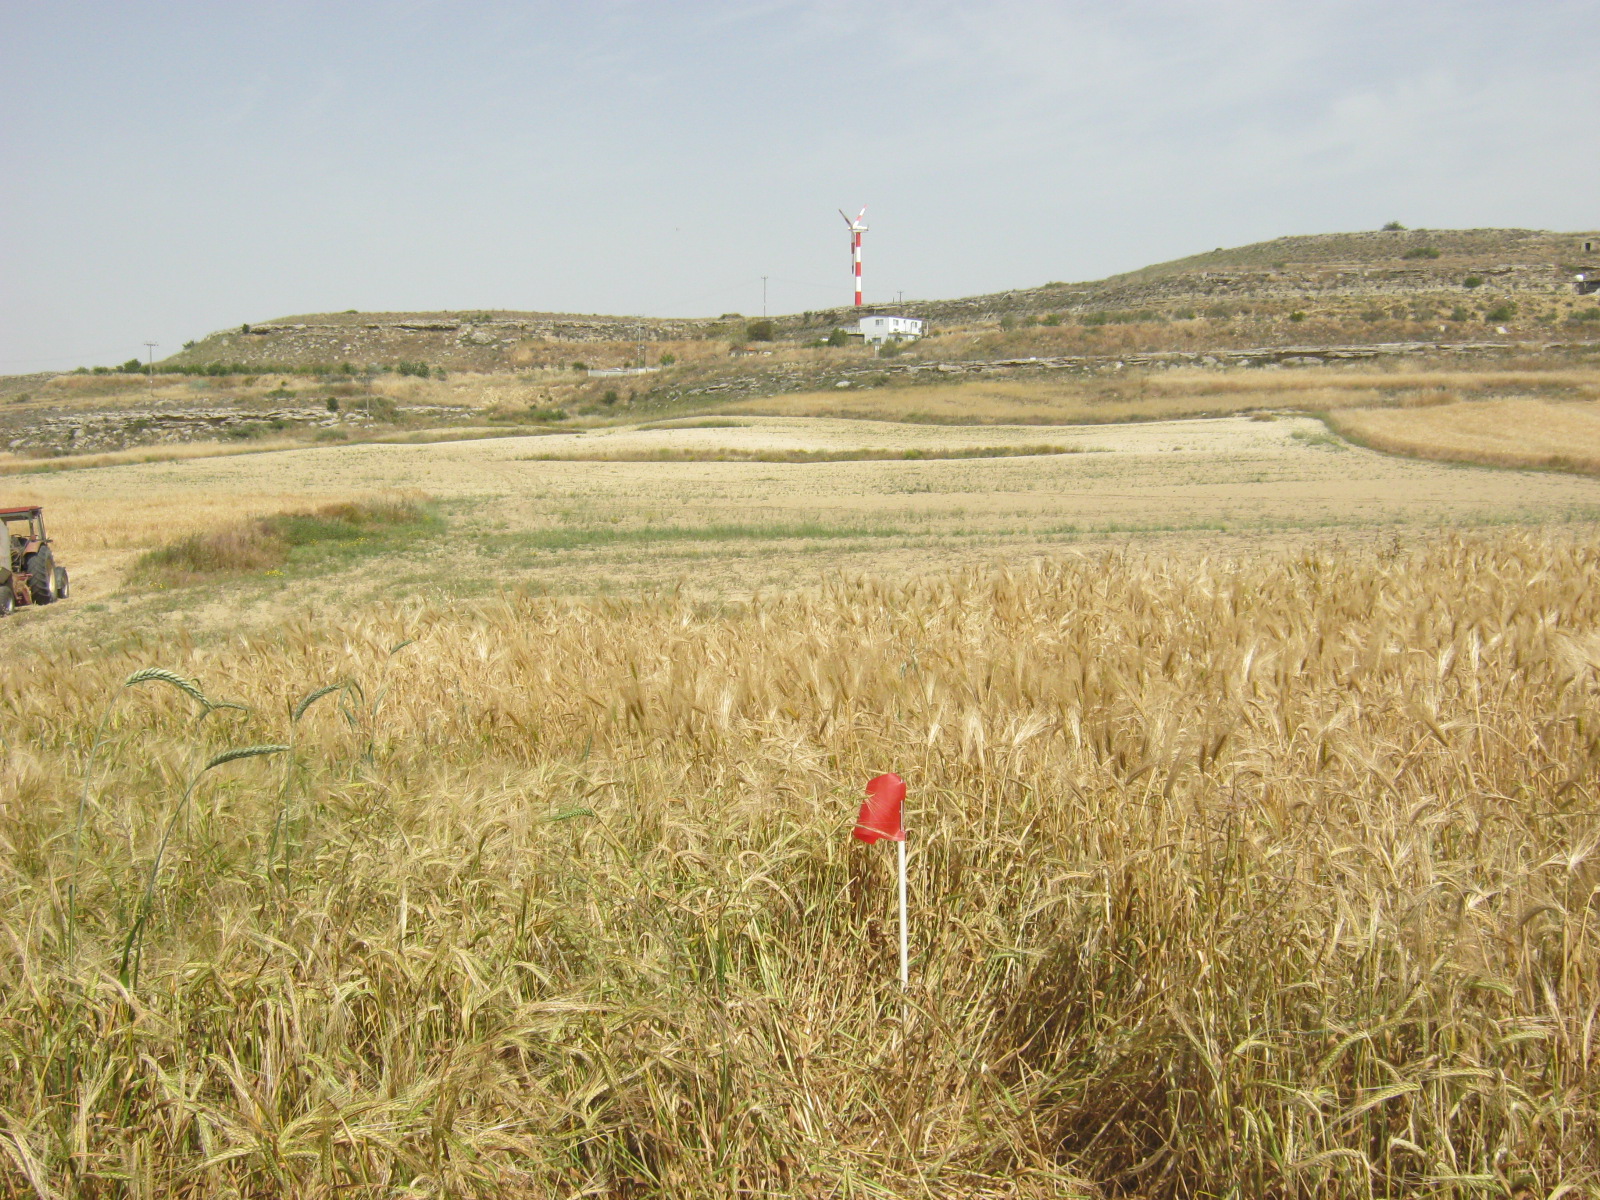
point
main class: Cropland
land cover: Barley
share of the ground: > 75 %
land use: Agriculture (excluding fallow land and kitchen gardens)
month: April
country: CY
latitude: 35.0819
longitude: 33.4117
